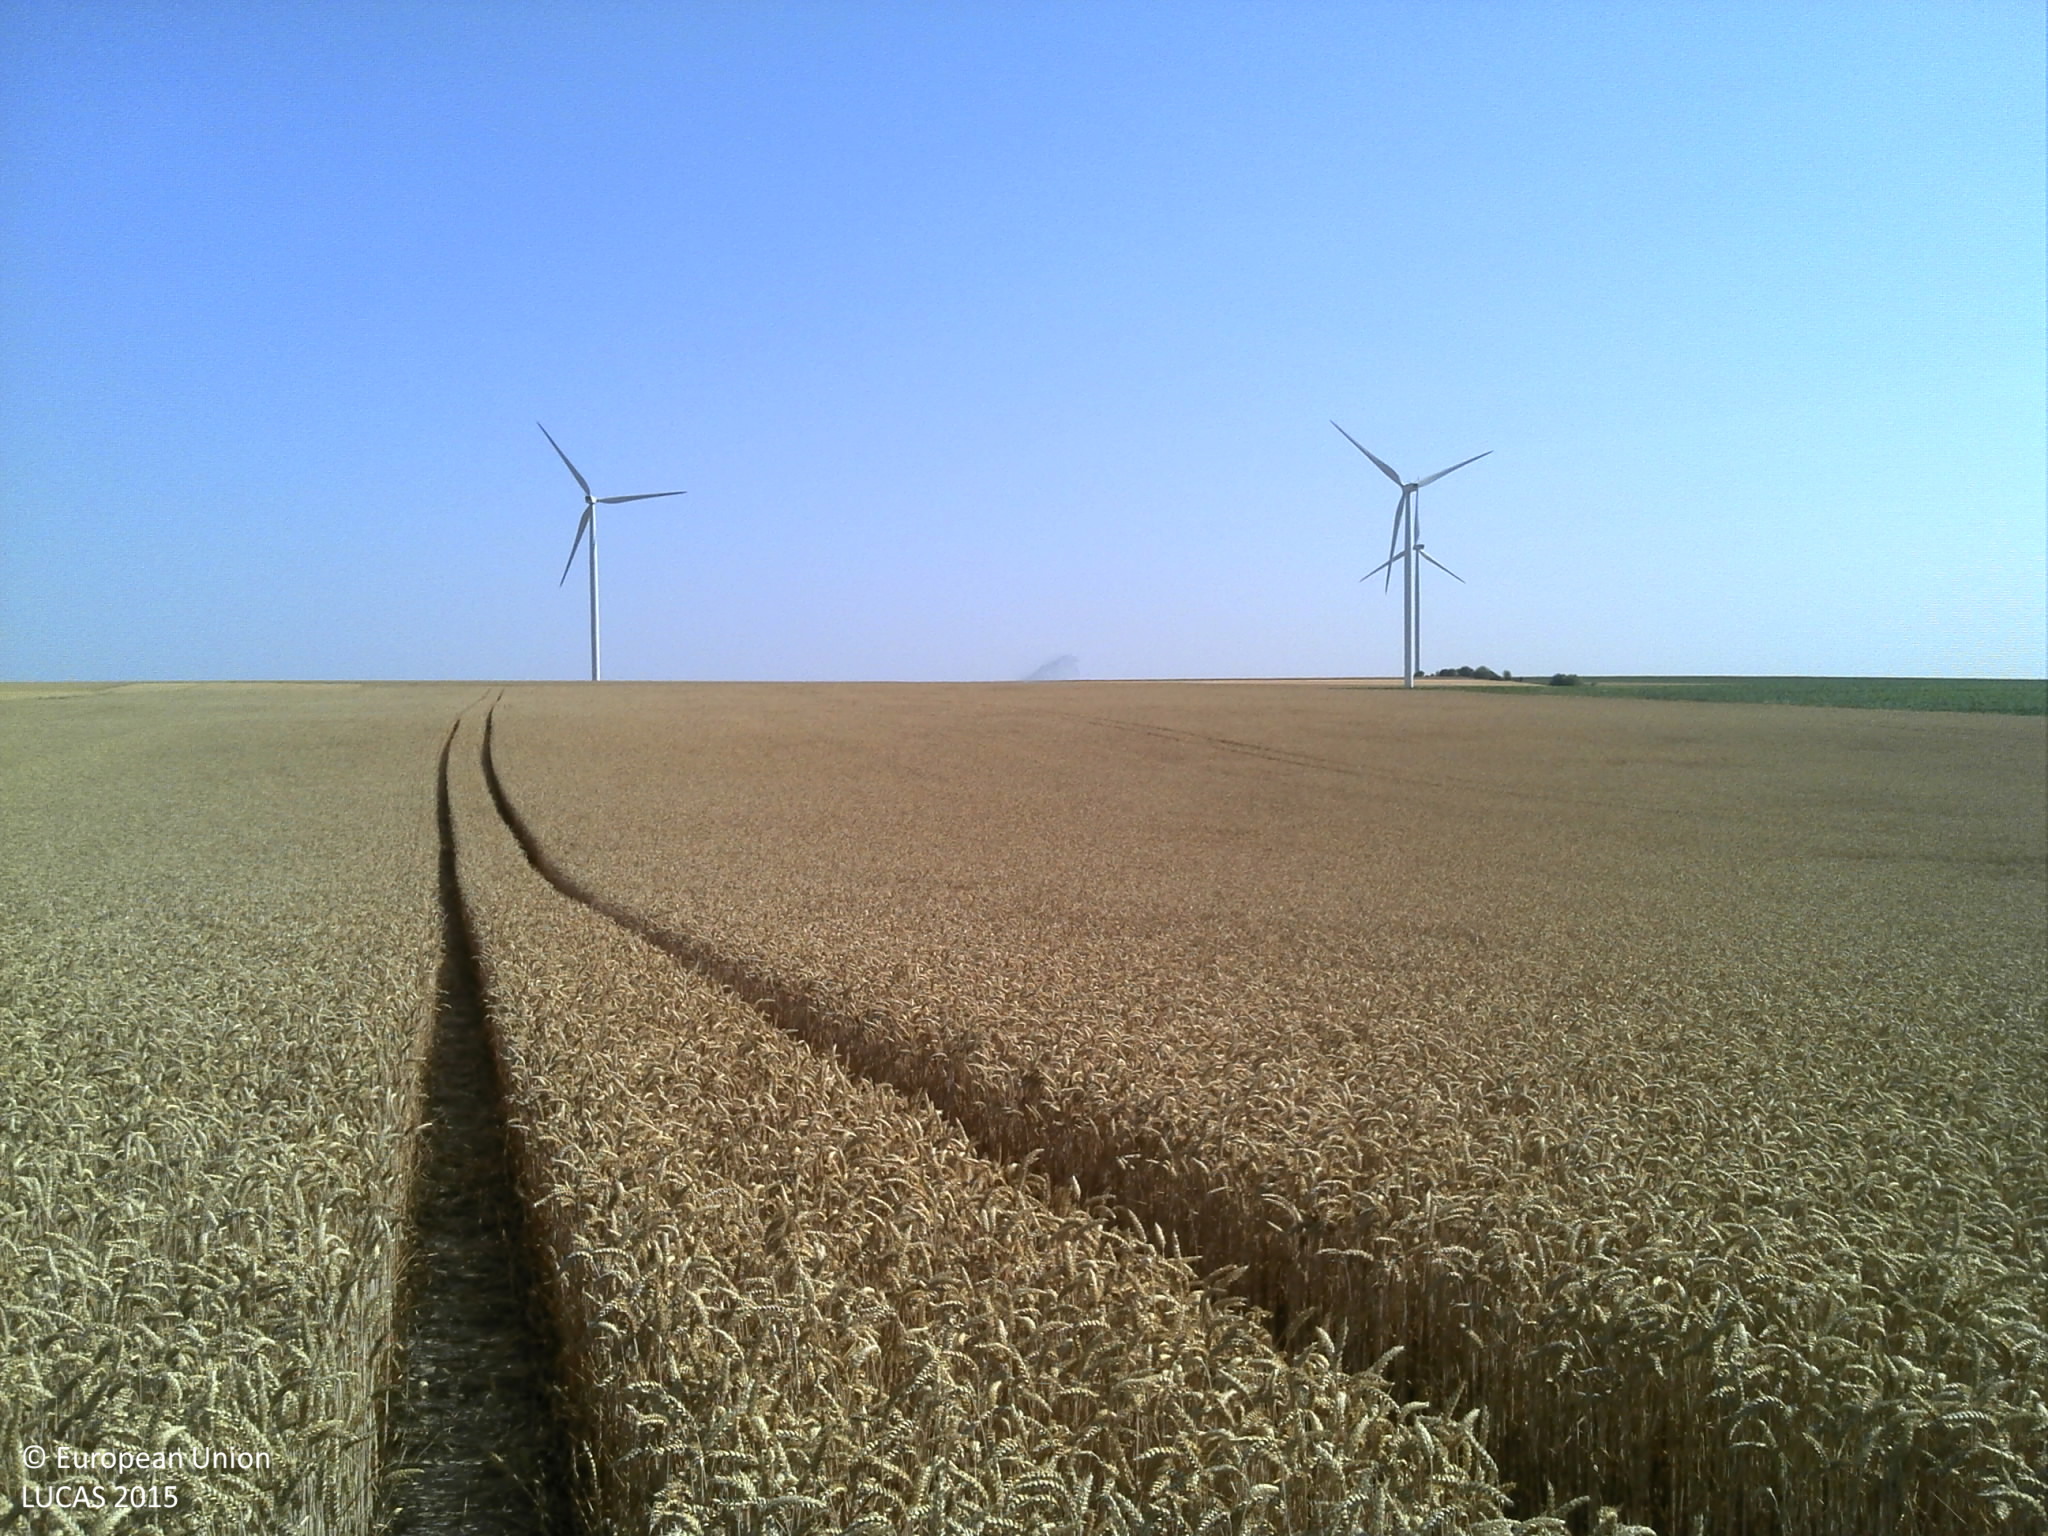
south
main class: Cropland
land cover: Common wheat
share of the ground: > 75 %
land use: Agriculture (excluding fallow land and kitchen gardens)
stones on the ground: < 10 %
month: July
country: FR
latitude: 49.4632
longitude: 4.2696
